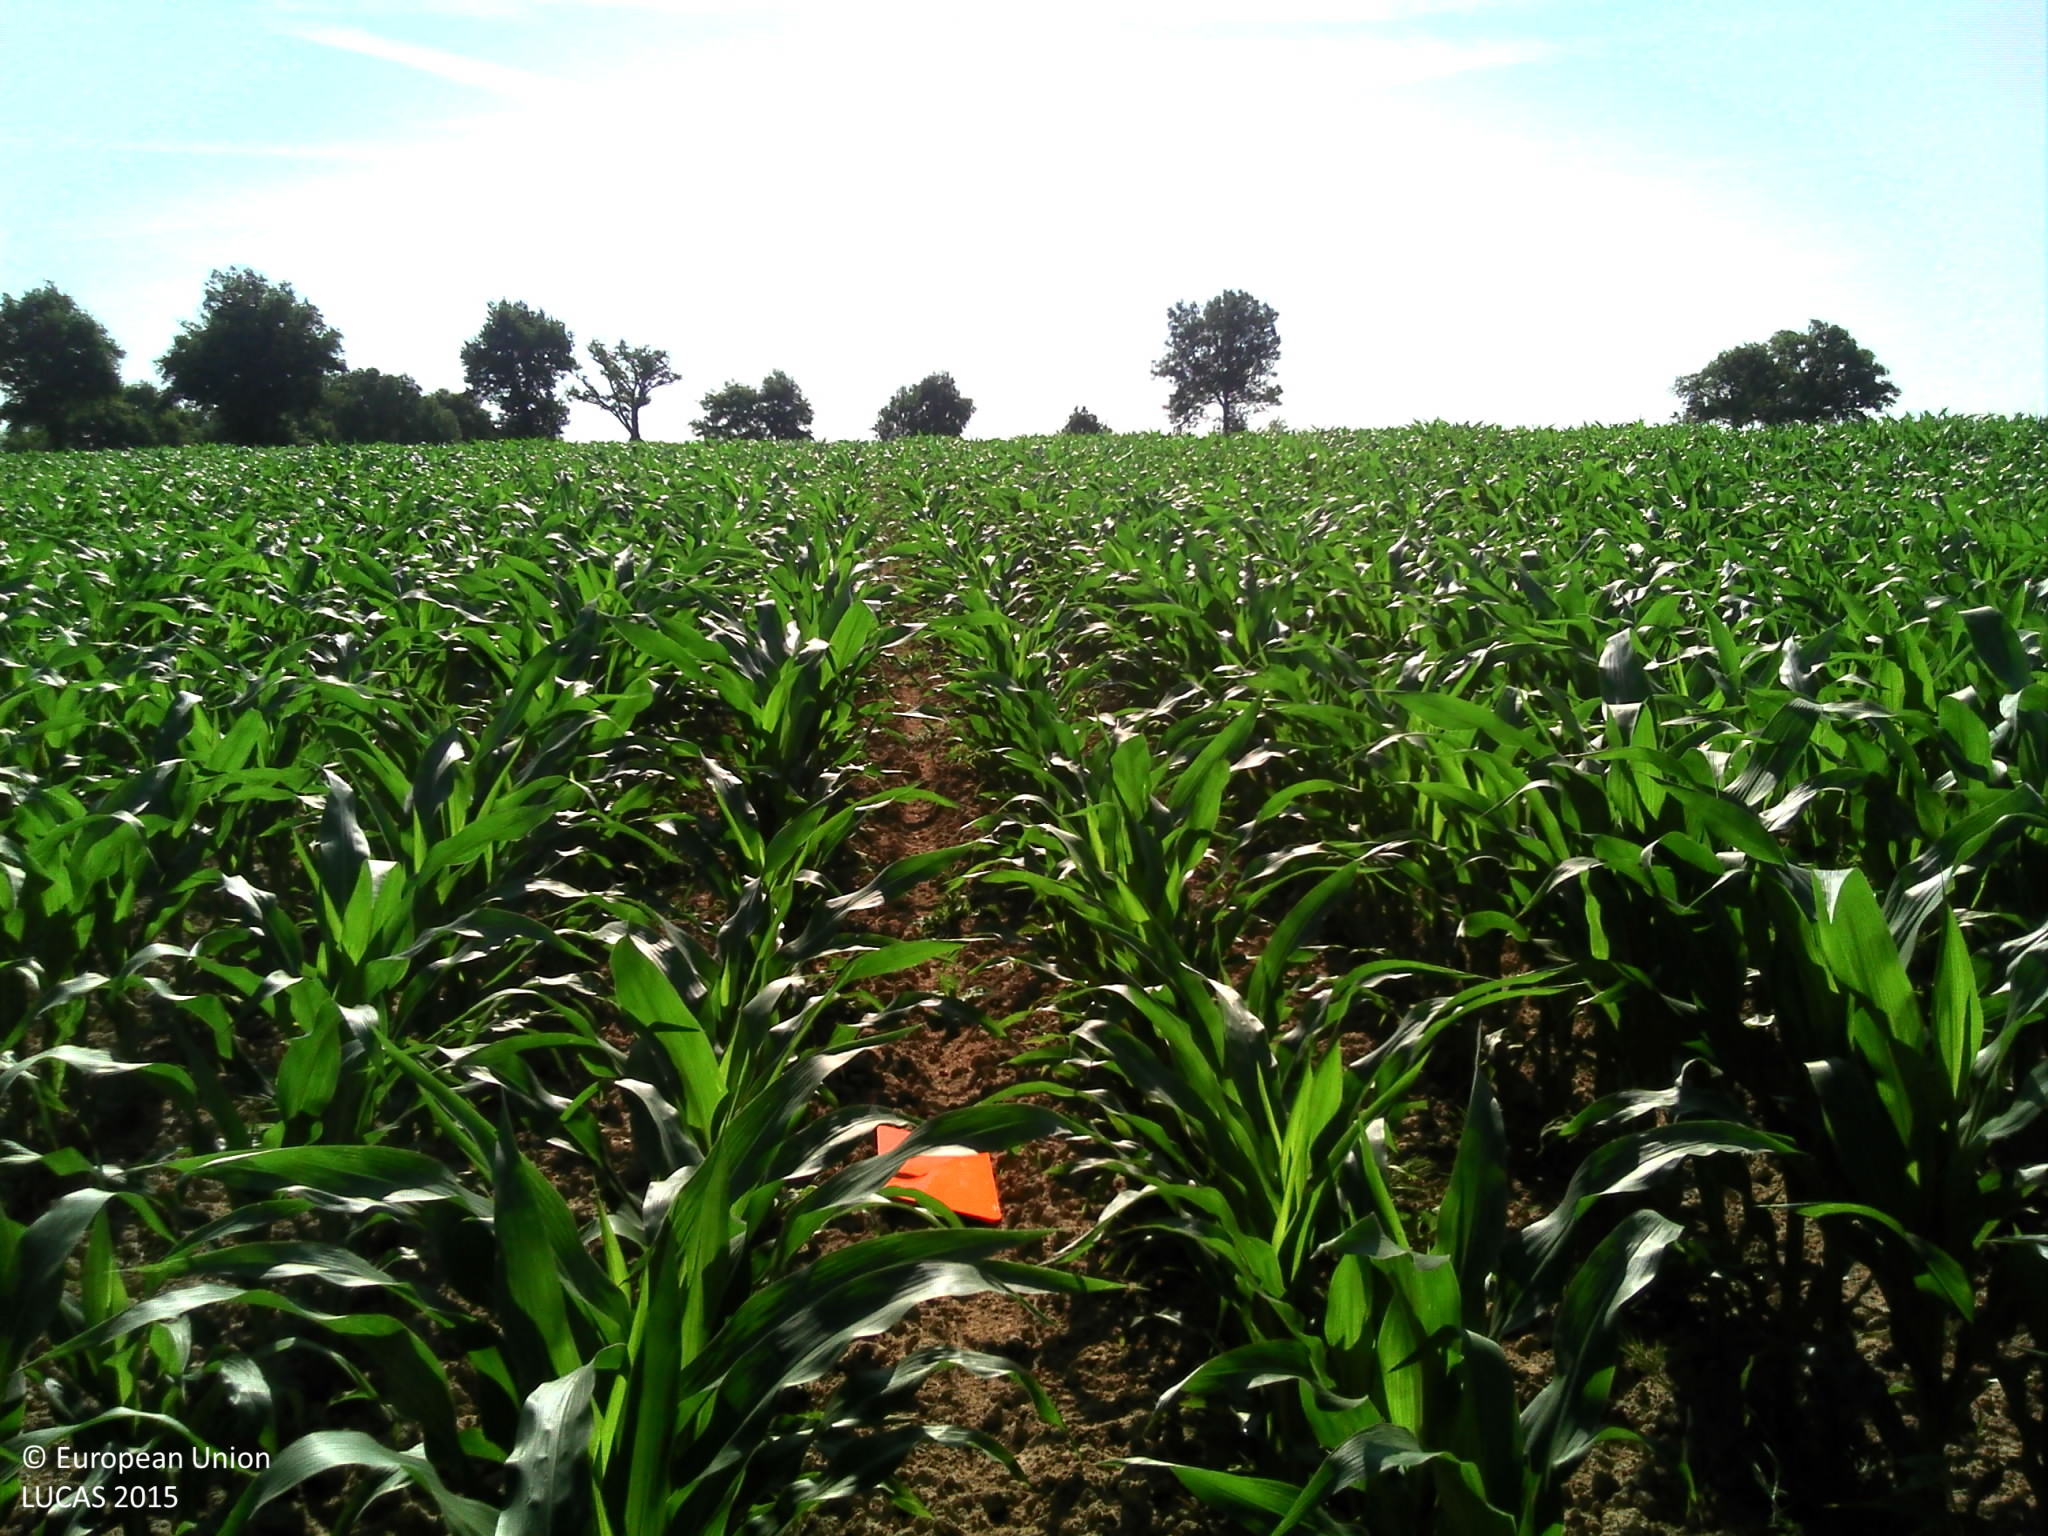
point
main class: Cropland
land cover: Maize
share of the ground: > 75 %
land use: Agriculture (excluding fallow land and kitchen gardens)
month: July
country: FR
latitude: 46.3078
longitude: 0.9103
